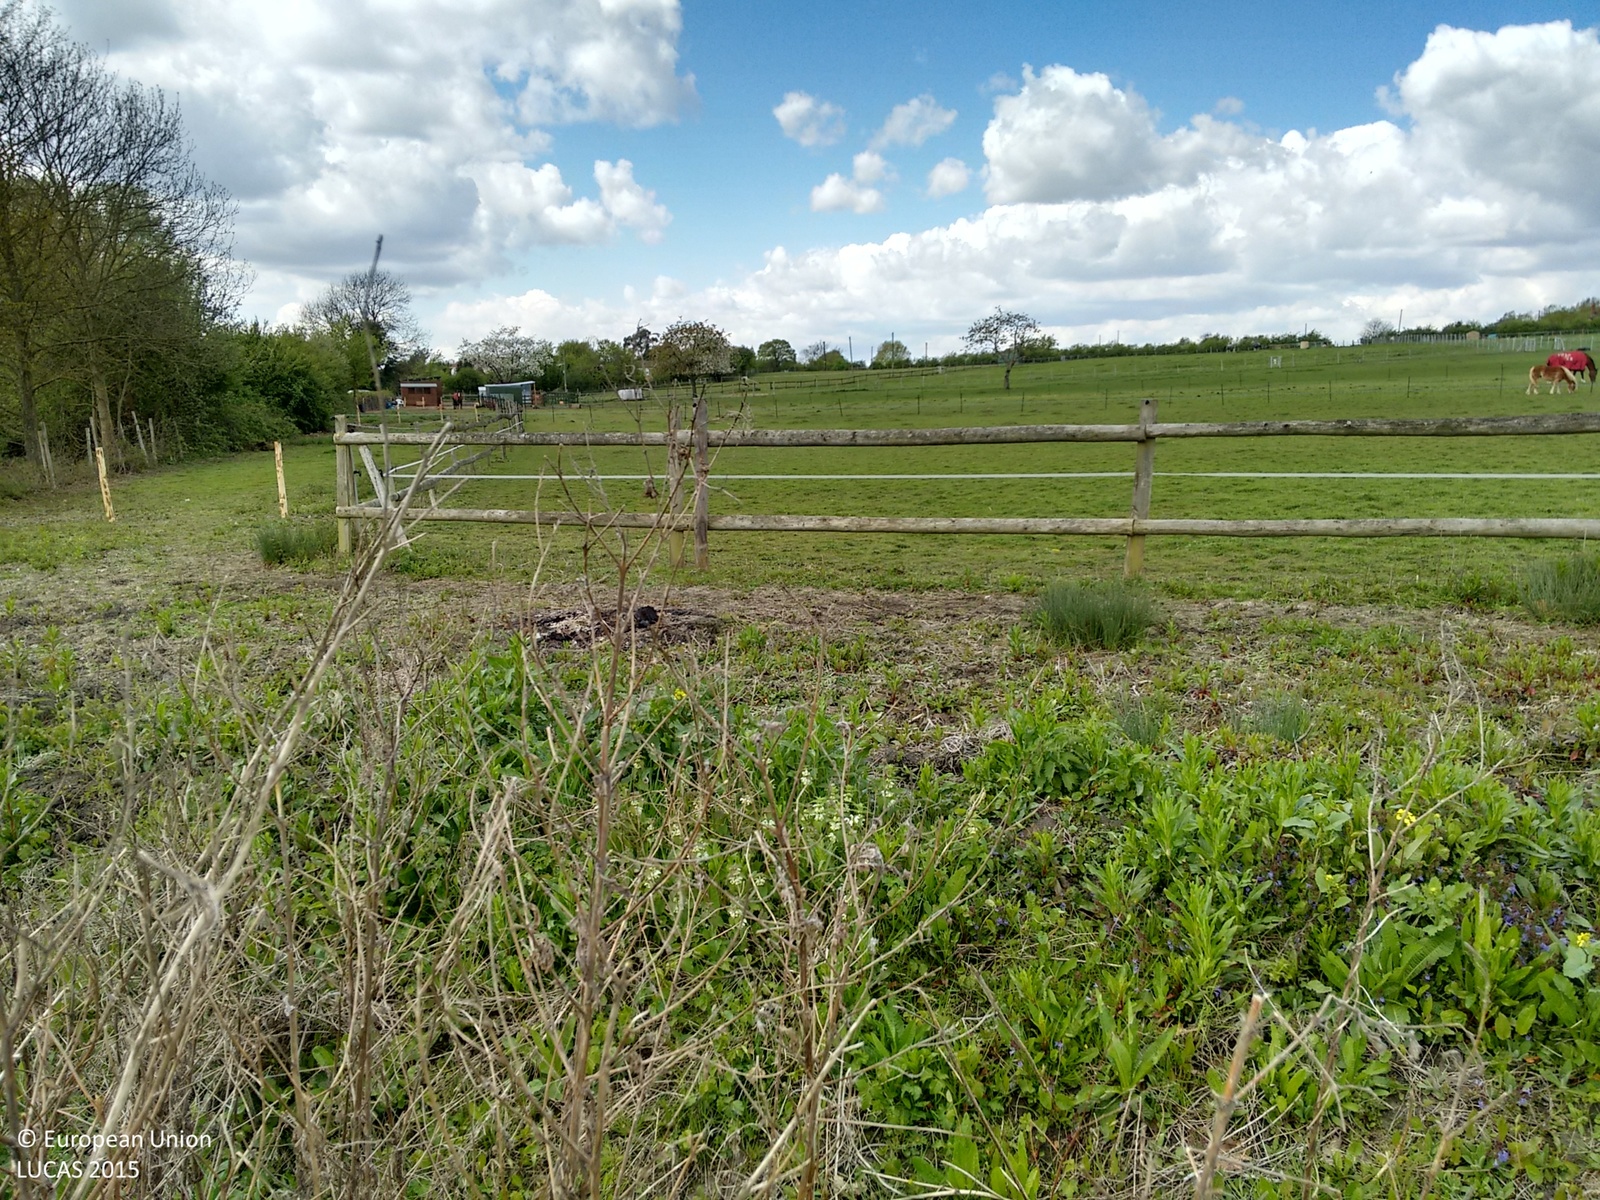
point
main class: Grassland
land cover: Grassland without tree/shrub cover
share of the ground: > 75 %
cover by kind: herbaceous plants 100 %
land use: Agriculture (excluding fallow land and kitchen gardens)
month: April
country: GB
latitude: 51.3069
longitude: 0.4901
